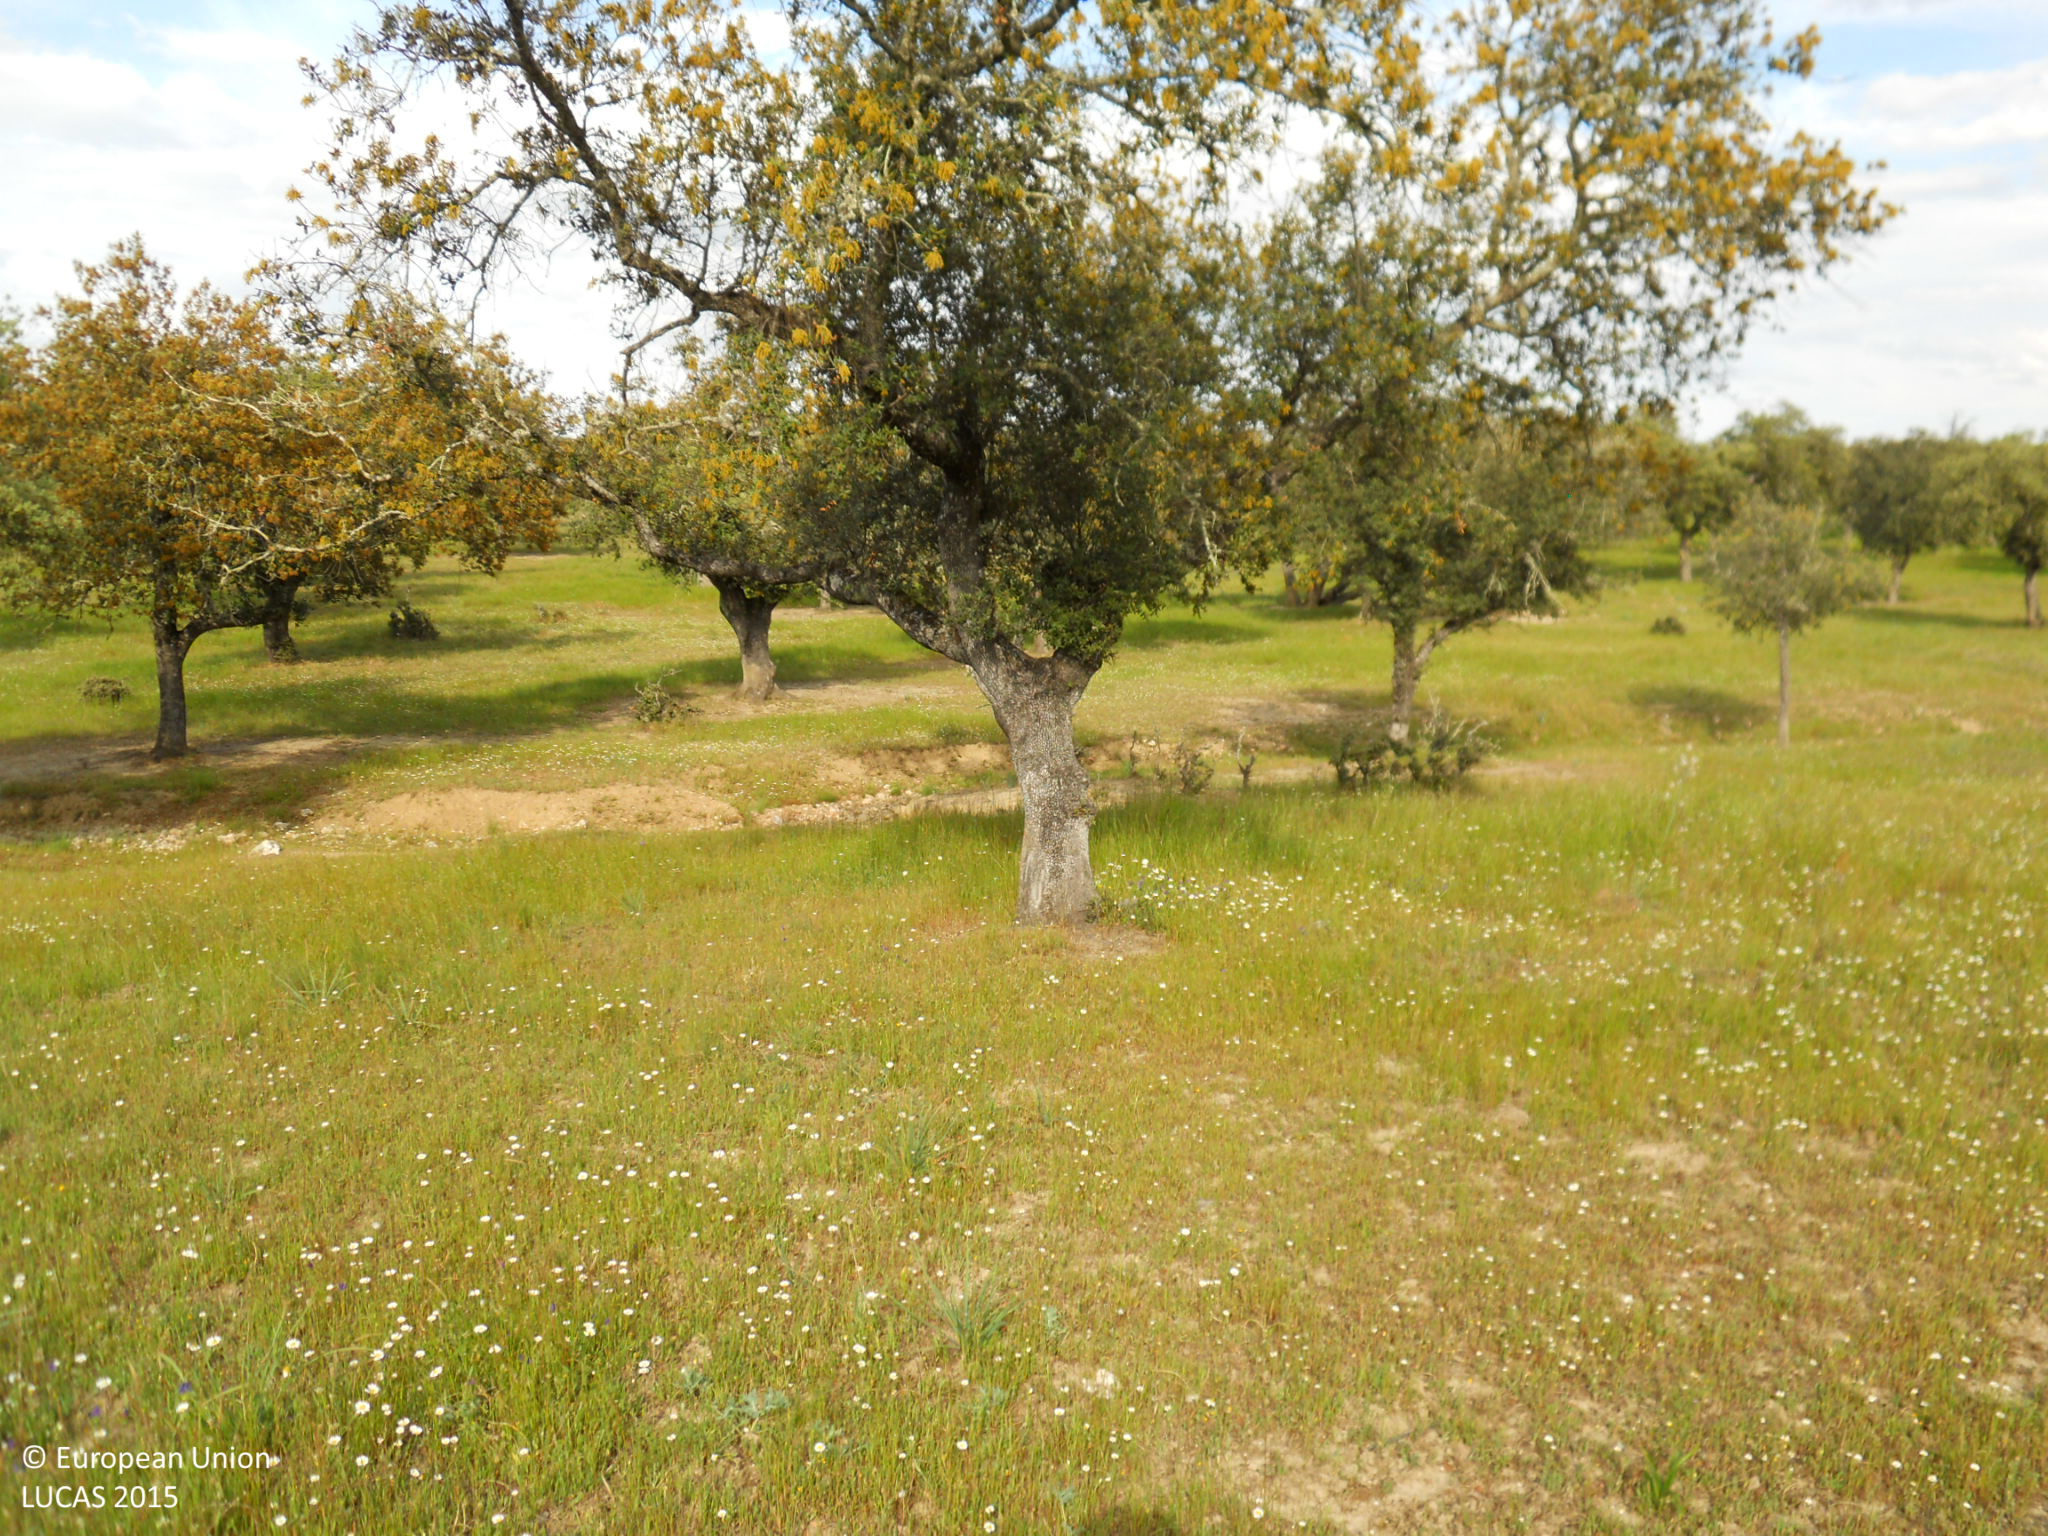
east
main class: Woodland
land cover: Broadleaved woodland
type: broadleaved evergreen forest
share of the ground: 10 - 25 %
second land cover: Grassland without tree/shrub cover
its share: > 75 %
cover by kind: herbaceous plants 65 %, broadleaved forest trees 35 %
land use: Forestry
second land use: Agriculture (excluding fallow land and kitchen gardens)
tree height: > 5 m
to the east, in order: Broadleaved woodland; Grassland without tree/shrub cover; Tracks; Broadleaved woodland; Artificial constructions in urban areas
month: April
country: ES
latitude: 39.2857
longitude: -6.8030
